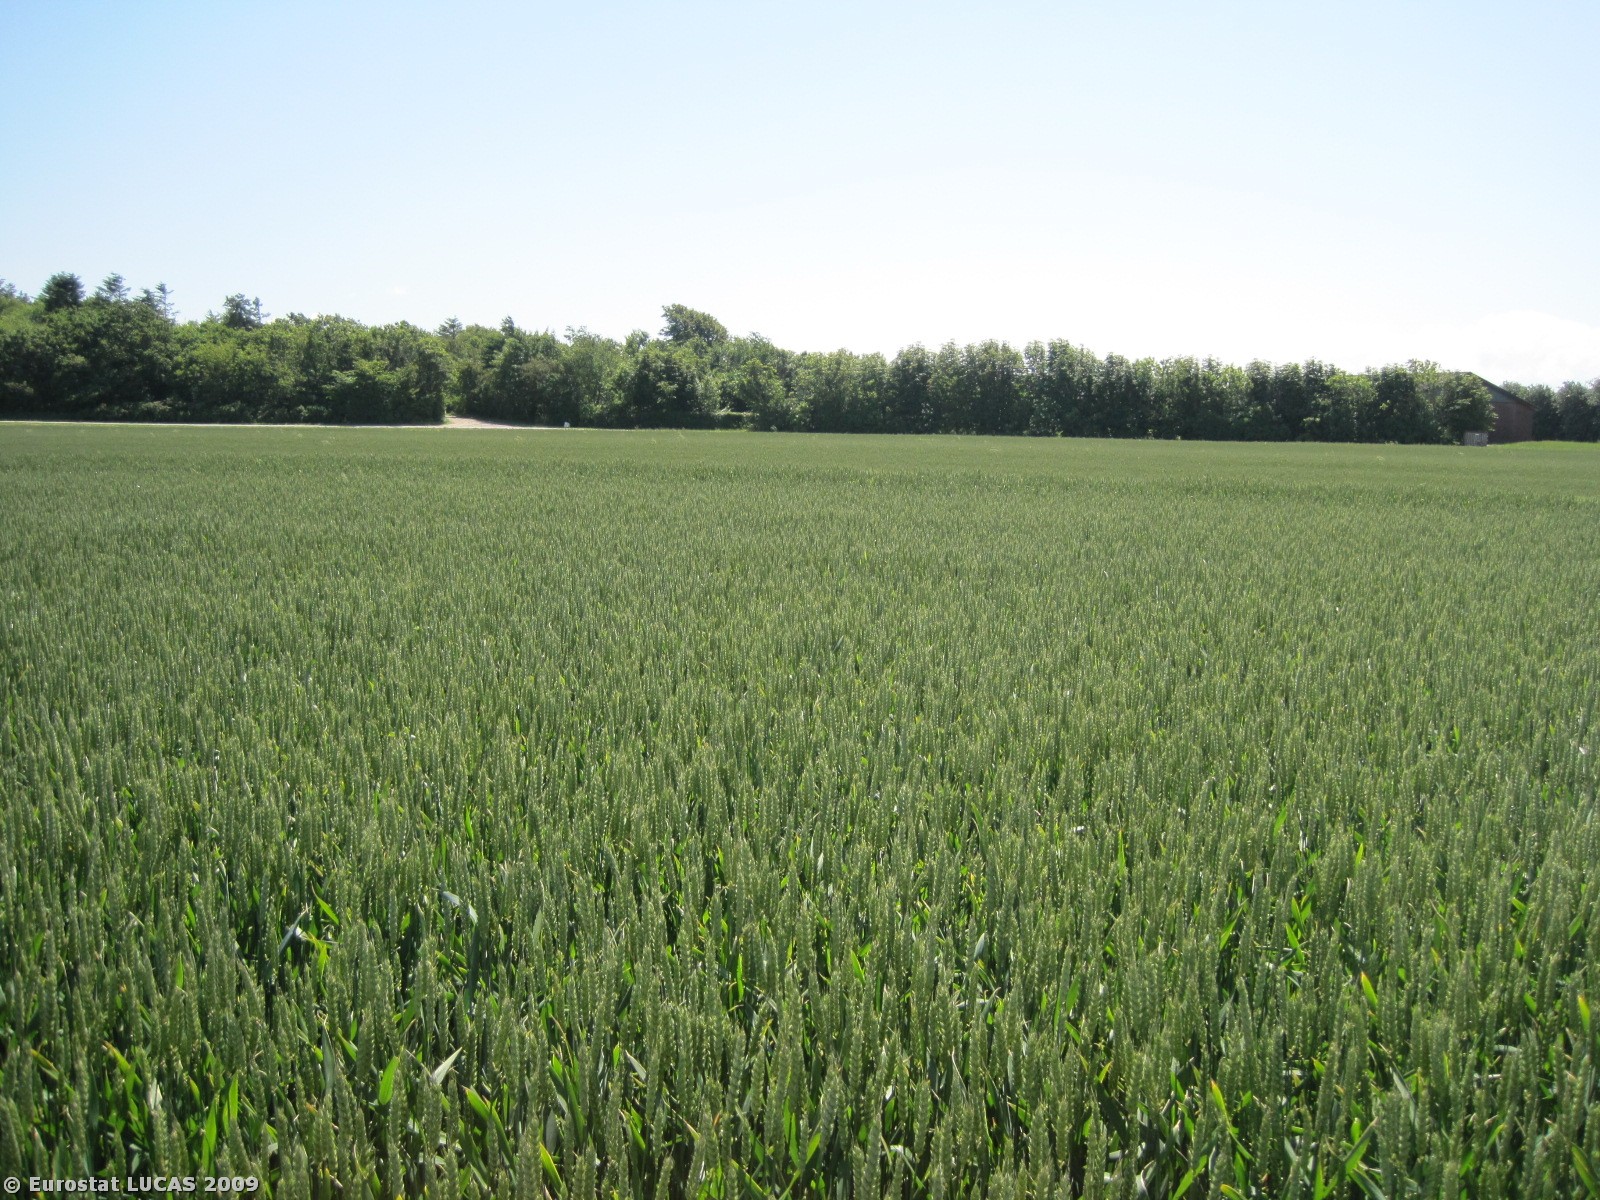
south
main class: Cropland
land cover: Common wheat
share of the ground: > 75 %
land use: Agriculture (excluding fallow land and kitchen gardens)
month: June
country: DK
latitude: 56.5415
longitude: 8.7818
